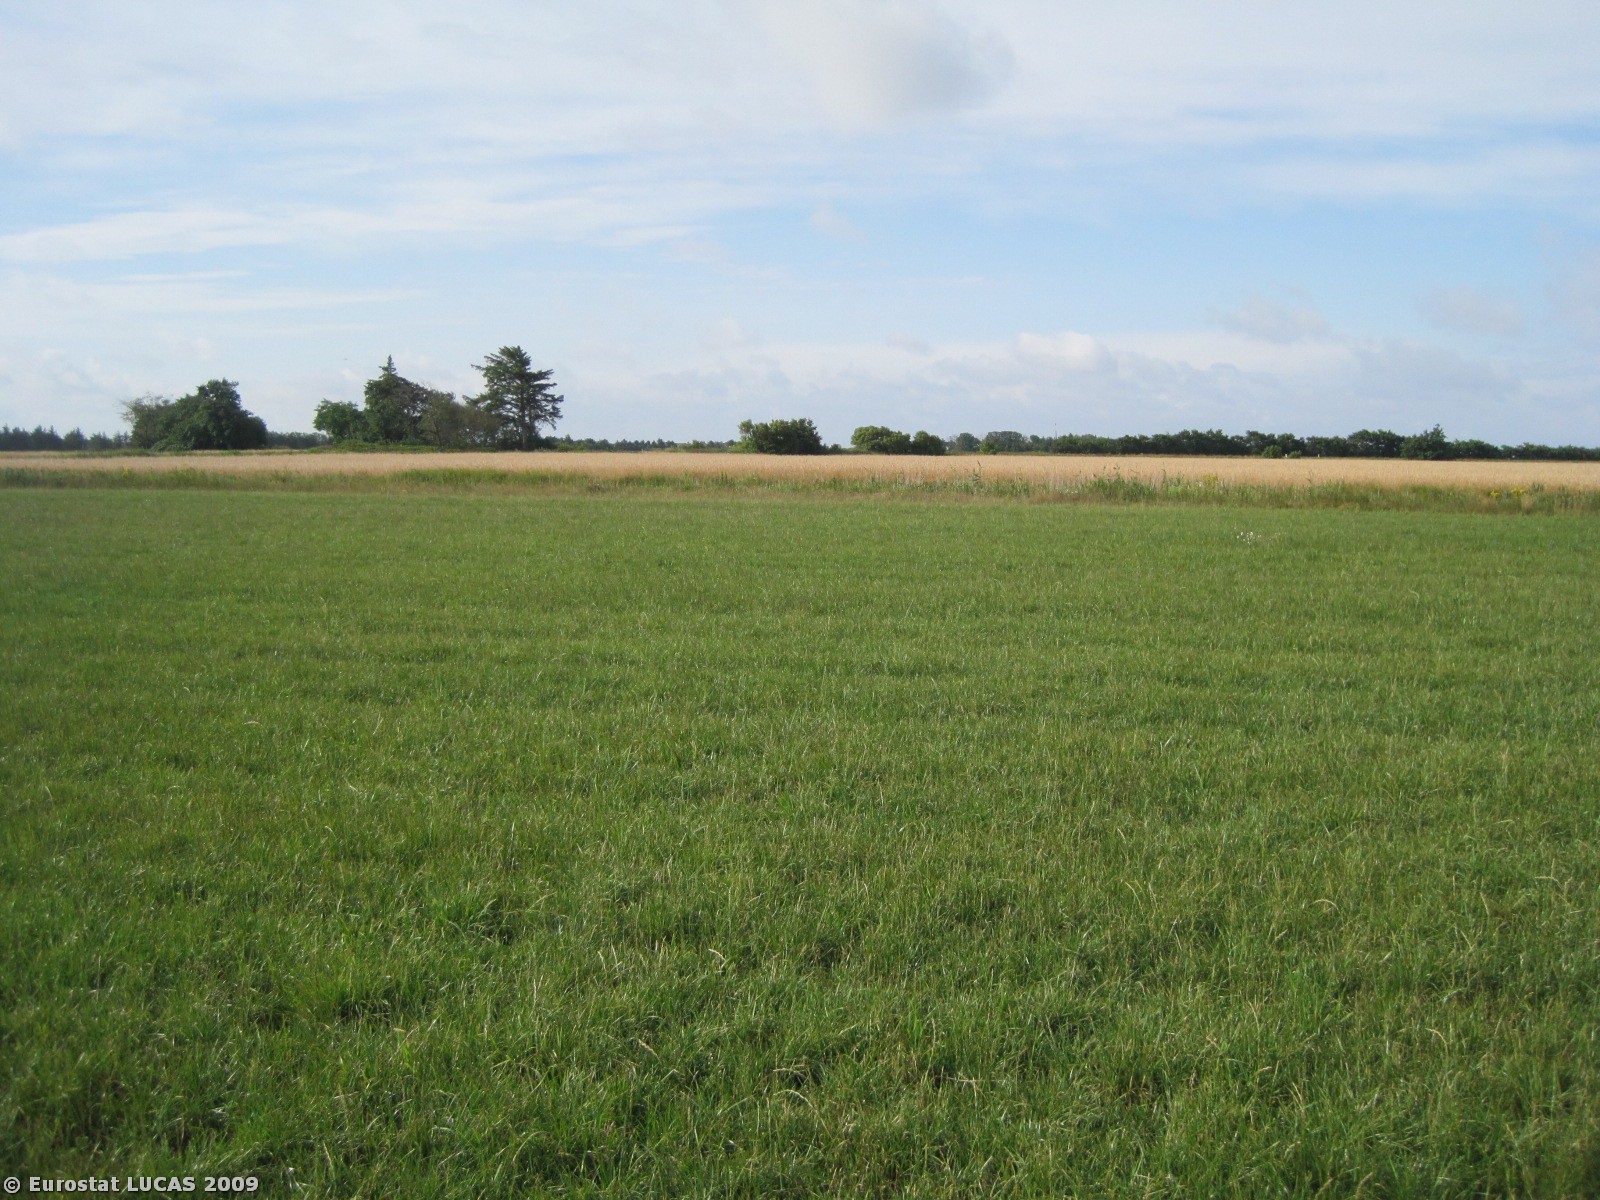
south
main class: Grassland
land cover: Grassland without tree/shrub cover
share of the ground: > 75 %
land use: Agriculture (excluding fallow land and kitchen gardens)
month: July
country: DK
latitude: 57.0480
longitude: 9.1606
